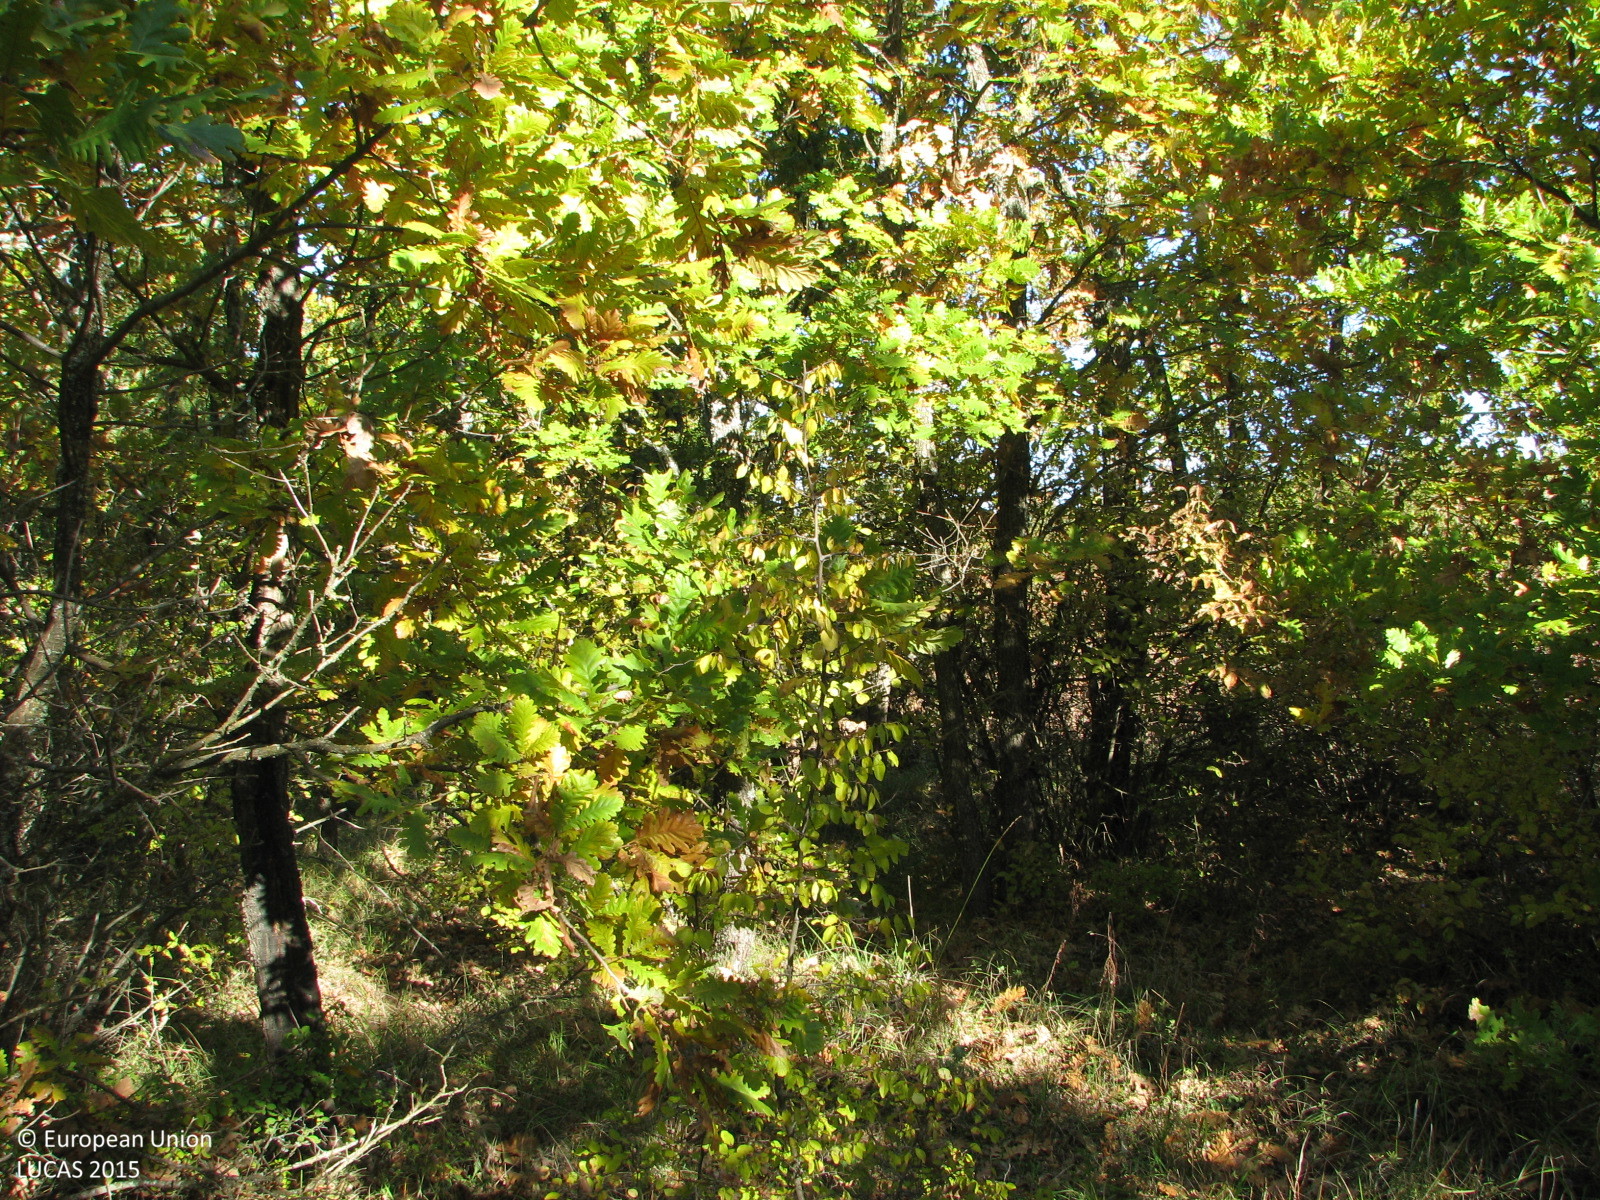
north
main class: Woodland
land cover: Broadleaved woodland
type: acidophilous oak and oak-birch forest
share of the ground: 50 - 75 %
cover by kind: broadleaved forest trees 60 %, herbaceous plants 30 %, shrubs 10 %
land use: Forestry
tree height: < 5 m
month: November
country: BG
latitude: 42.0196
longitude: 26.6463
